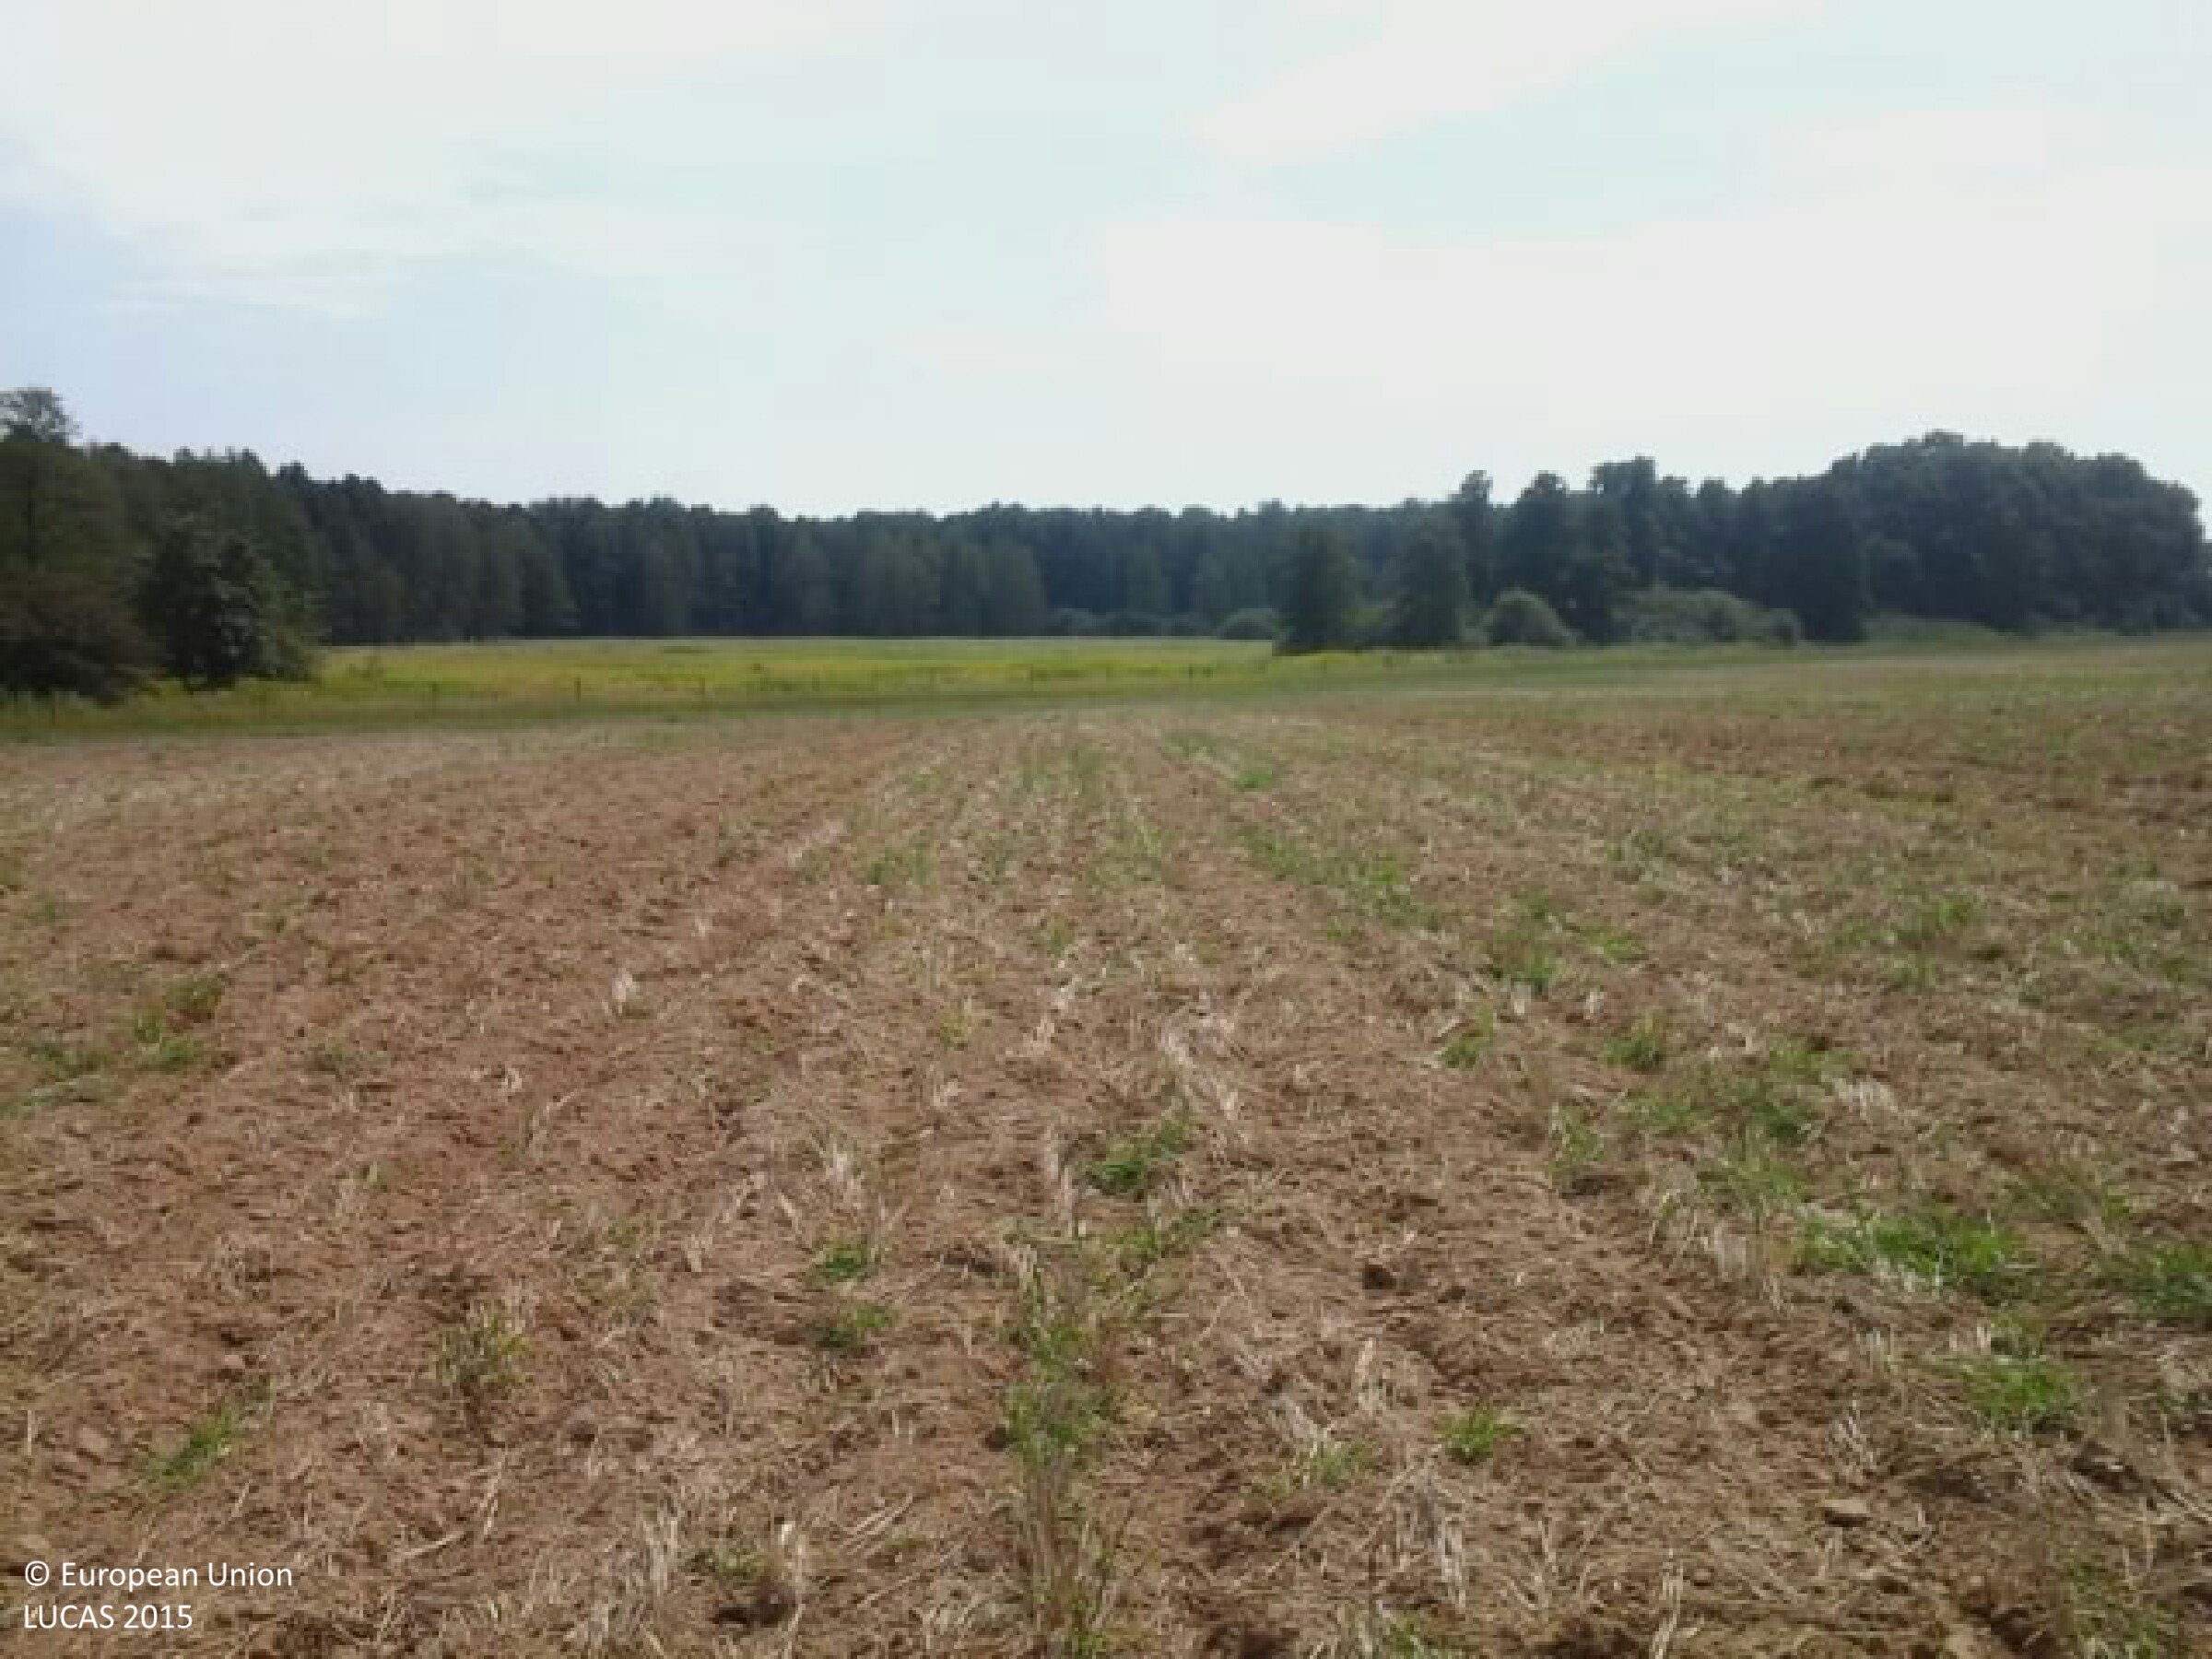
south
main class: Cropland
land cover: Common wheat
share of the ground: 25 - 50 %
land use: Agriculture (excluding fallow land and kitchen gardens)
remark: Harvested field
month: August
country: HU
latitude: 46.5557
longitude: 17.2694
